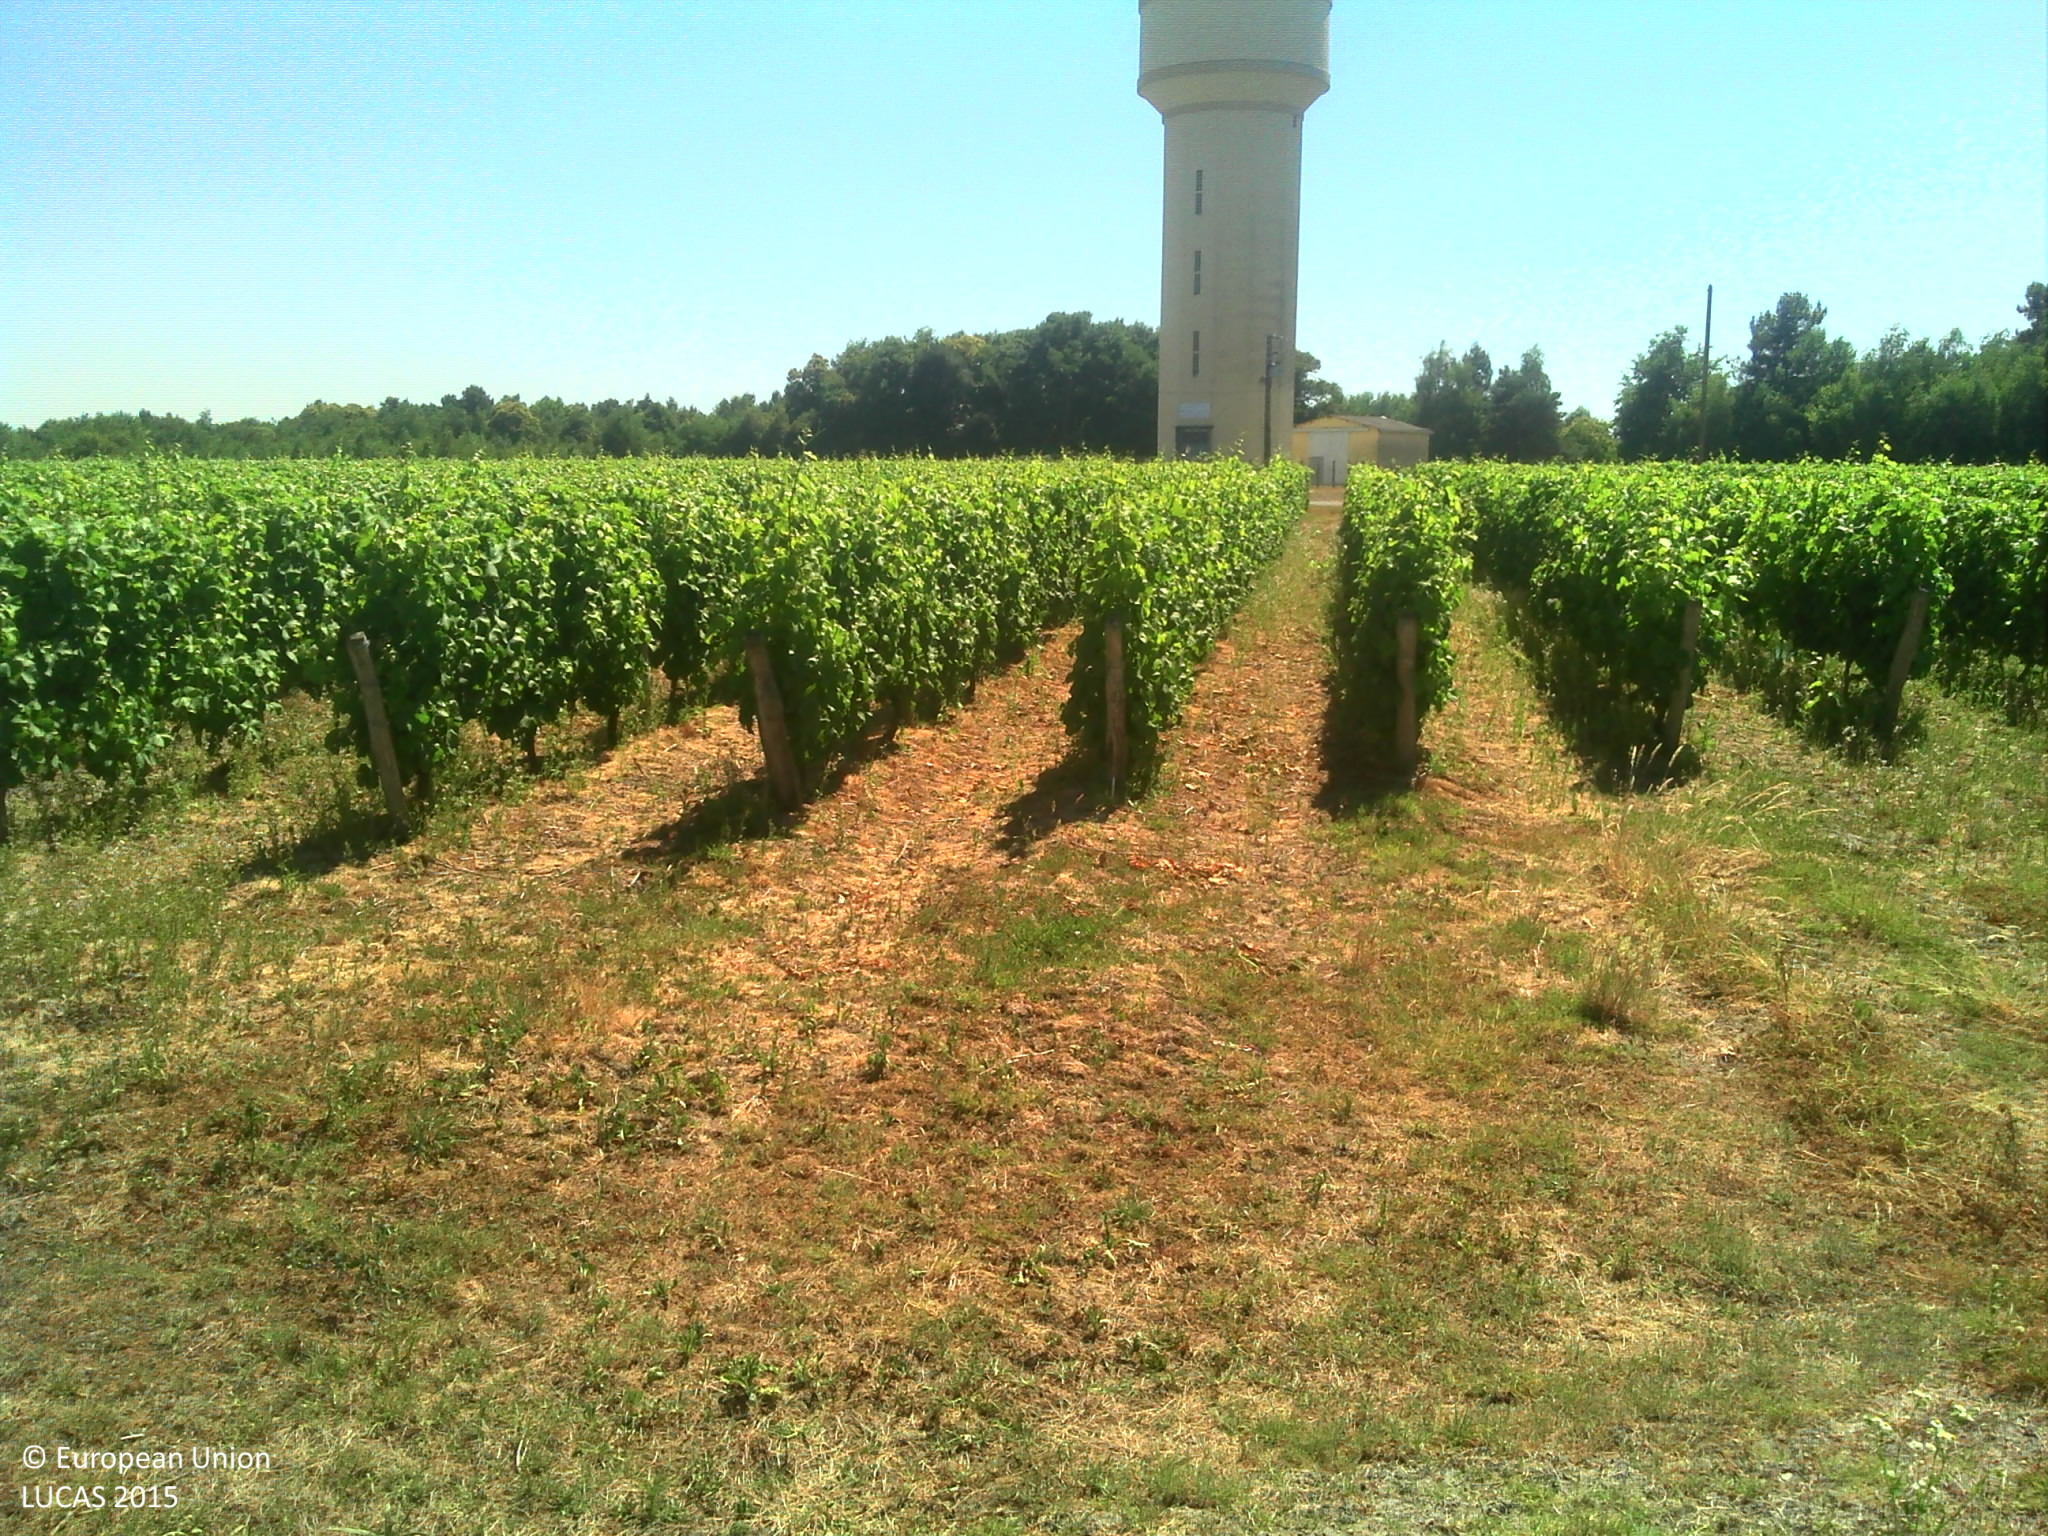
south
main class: Grassland
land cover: Grassland without tree/shrub cover
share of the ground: > 75 %
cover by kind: herbaceous plants 80 %, unconsolidated bare surface 20 %
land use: Agriculture (excluding fallow land and kitchen gardens)
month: June
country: FR
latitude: 47.3059
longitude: 1.3754
